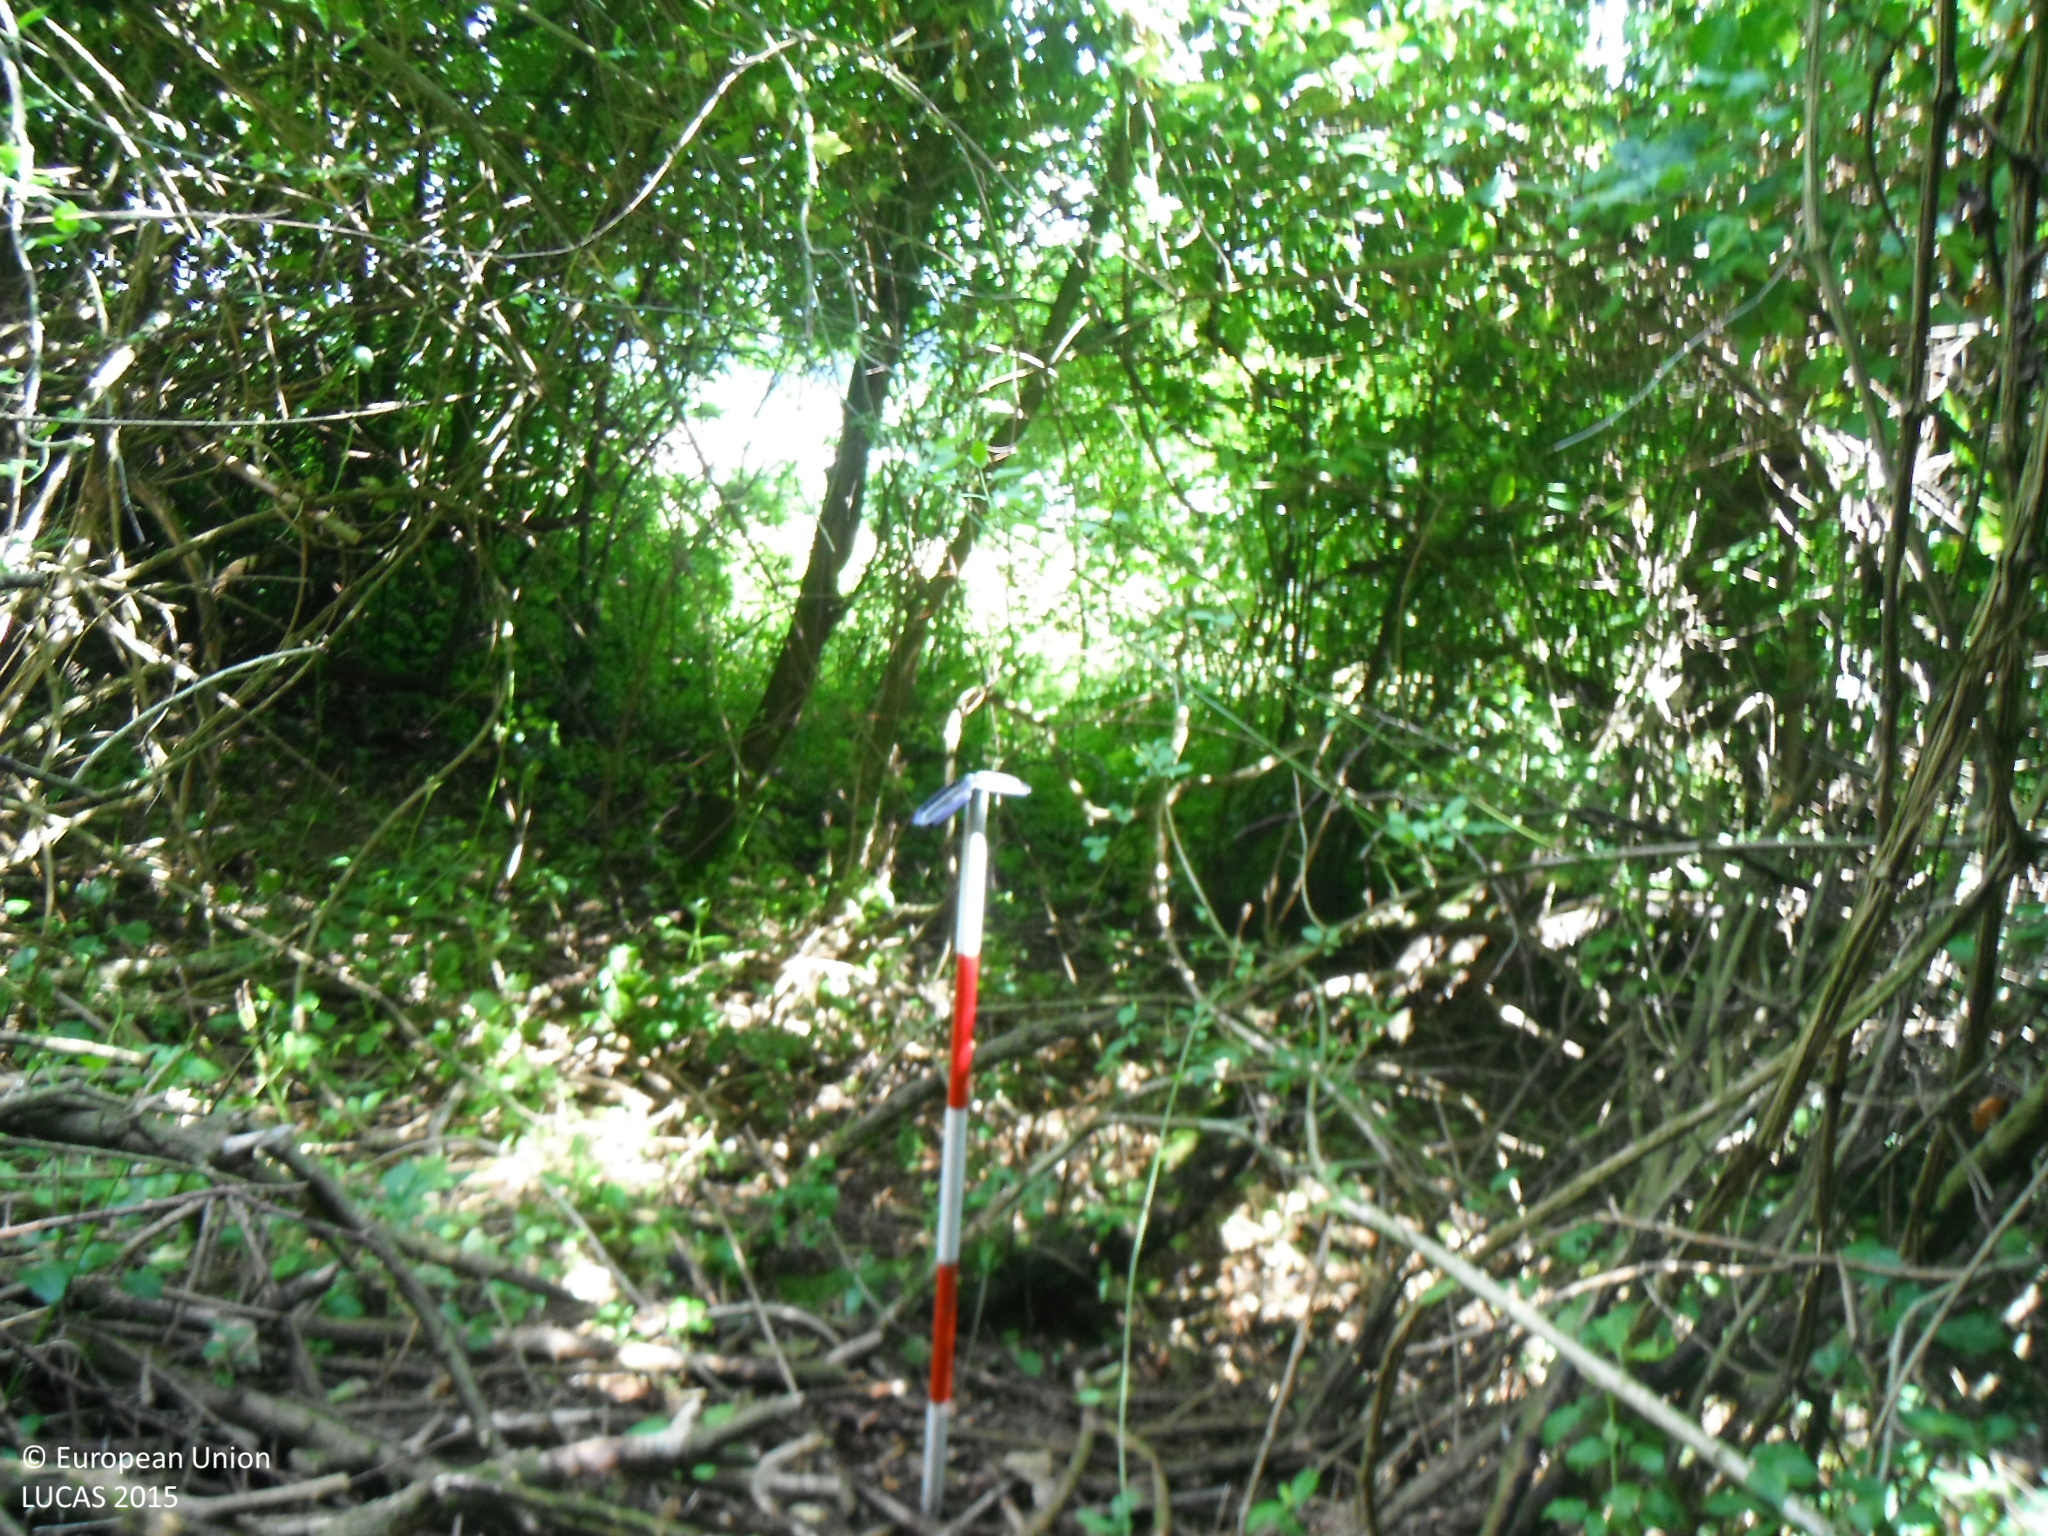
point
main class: Shrubland
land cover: Shrubland with sparse tree cover
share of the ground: > 75 %
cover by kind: shrubs 95 %, broadleaved forest trees 5 %
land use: Forestry
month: July
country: SK
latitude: 49.0418
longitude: 18.4032
